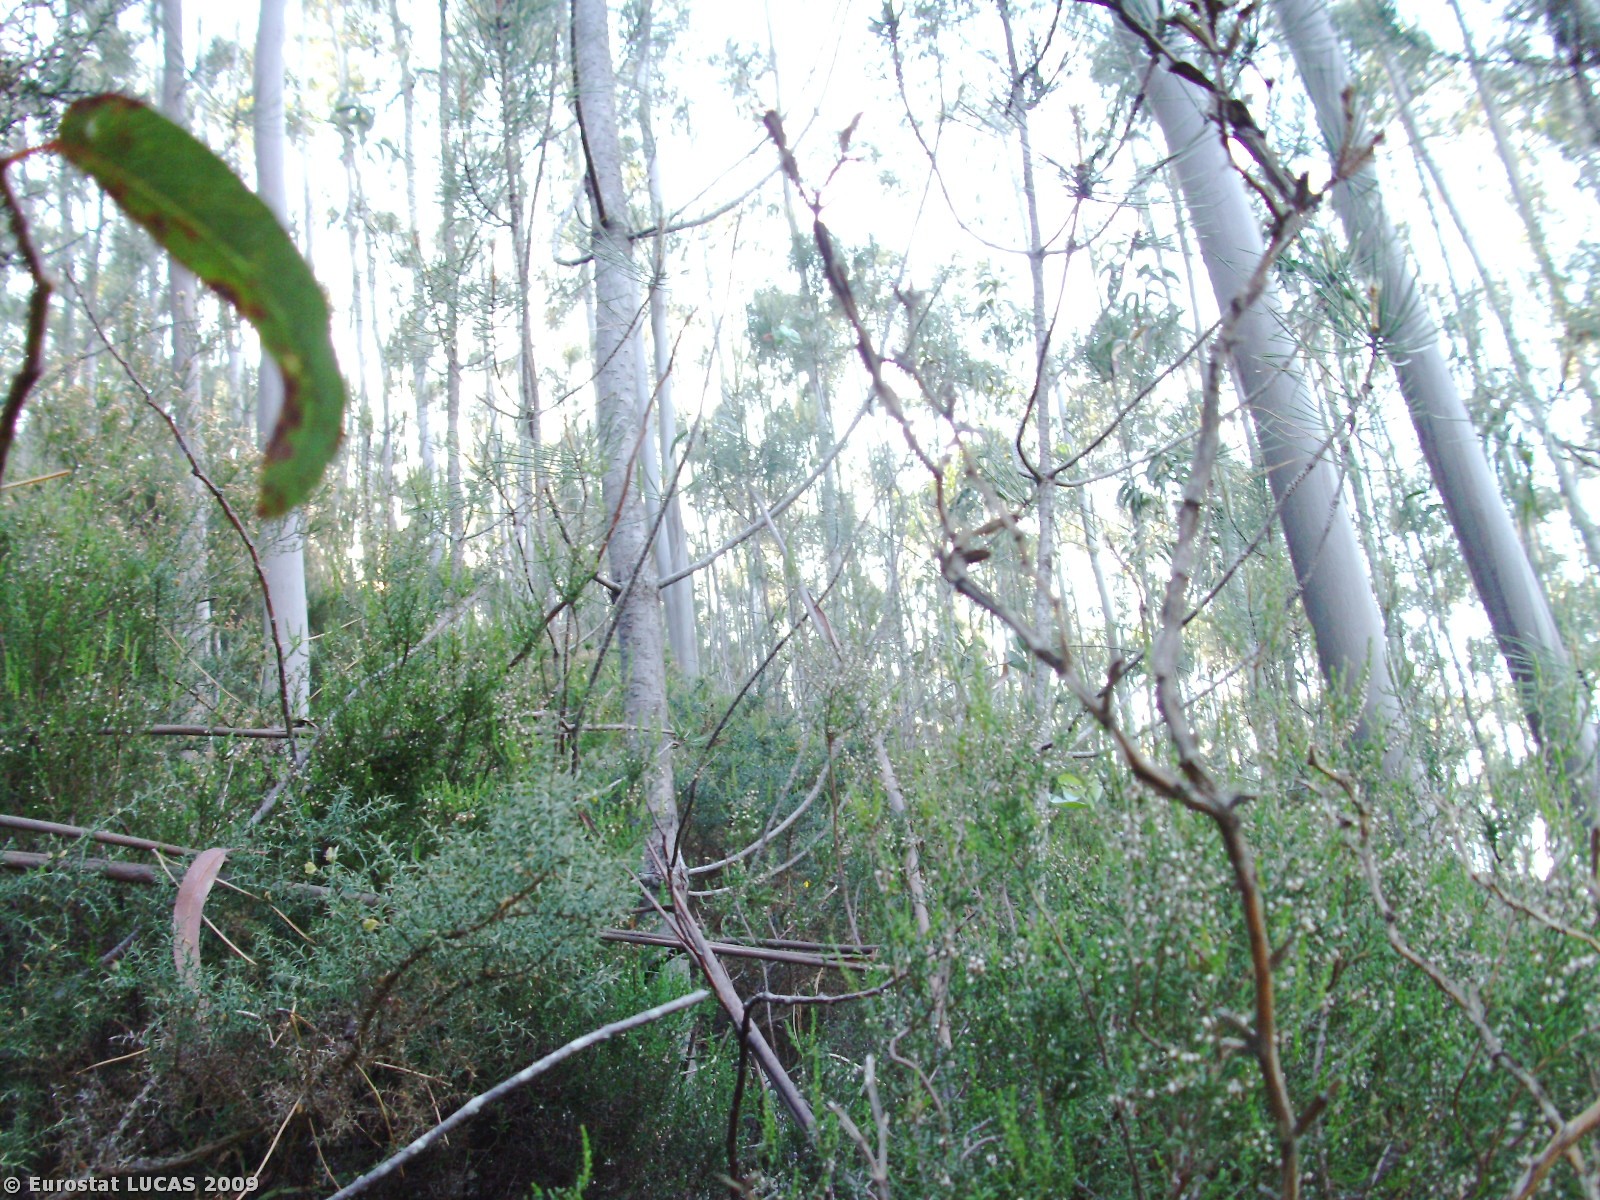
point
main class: Woodland
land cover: Broadleaved woodland
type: plantations and self-sown exotic forest
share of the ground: > 75 %
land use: Forestry
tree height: > 5 m
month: May
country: PT
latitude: 40.7408
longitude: -8.4366
